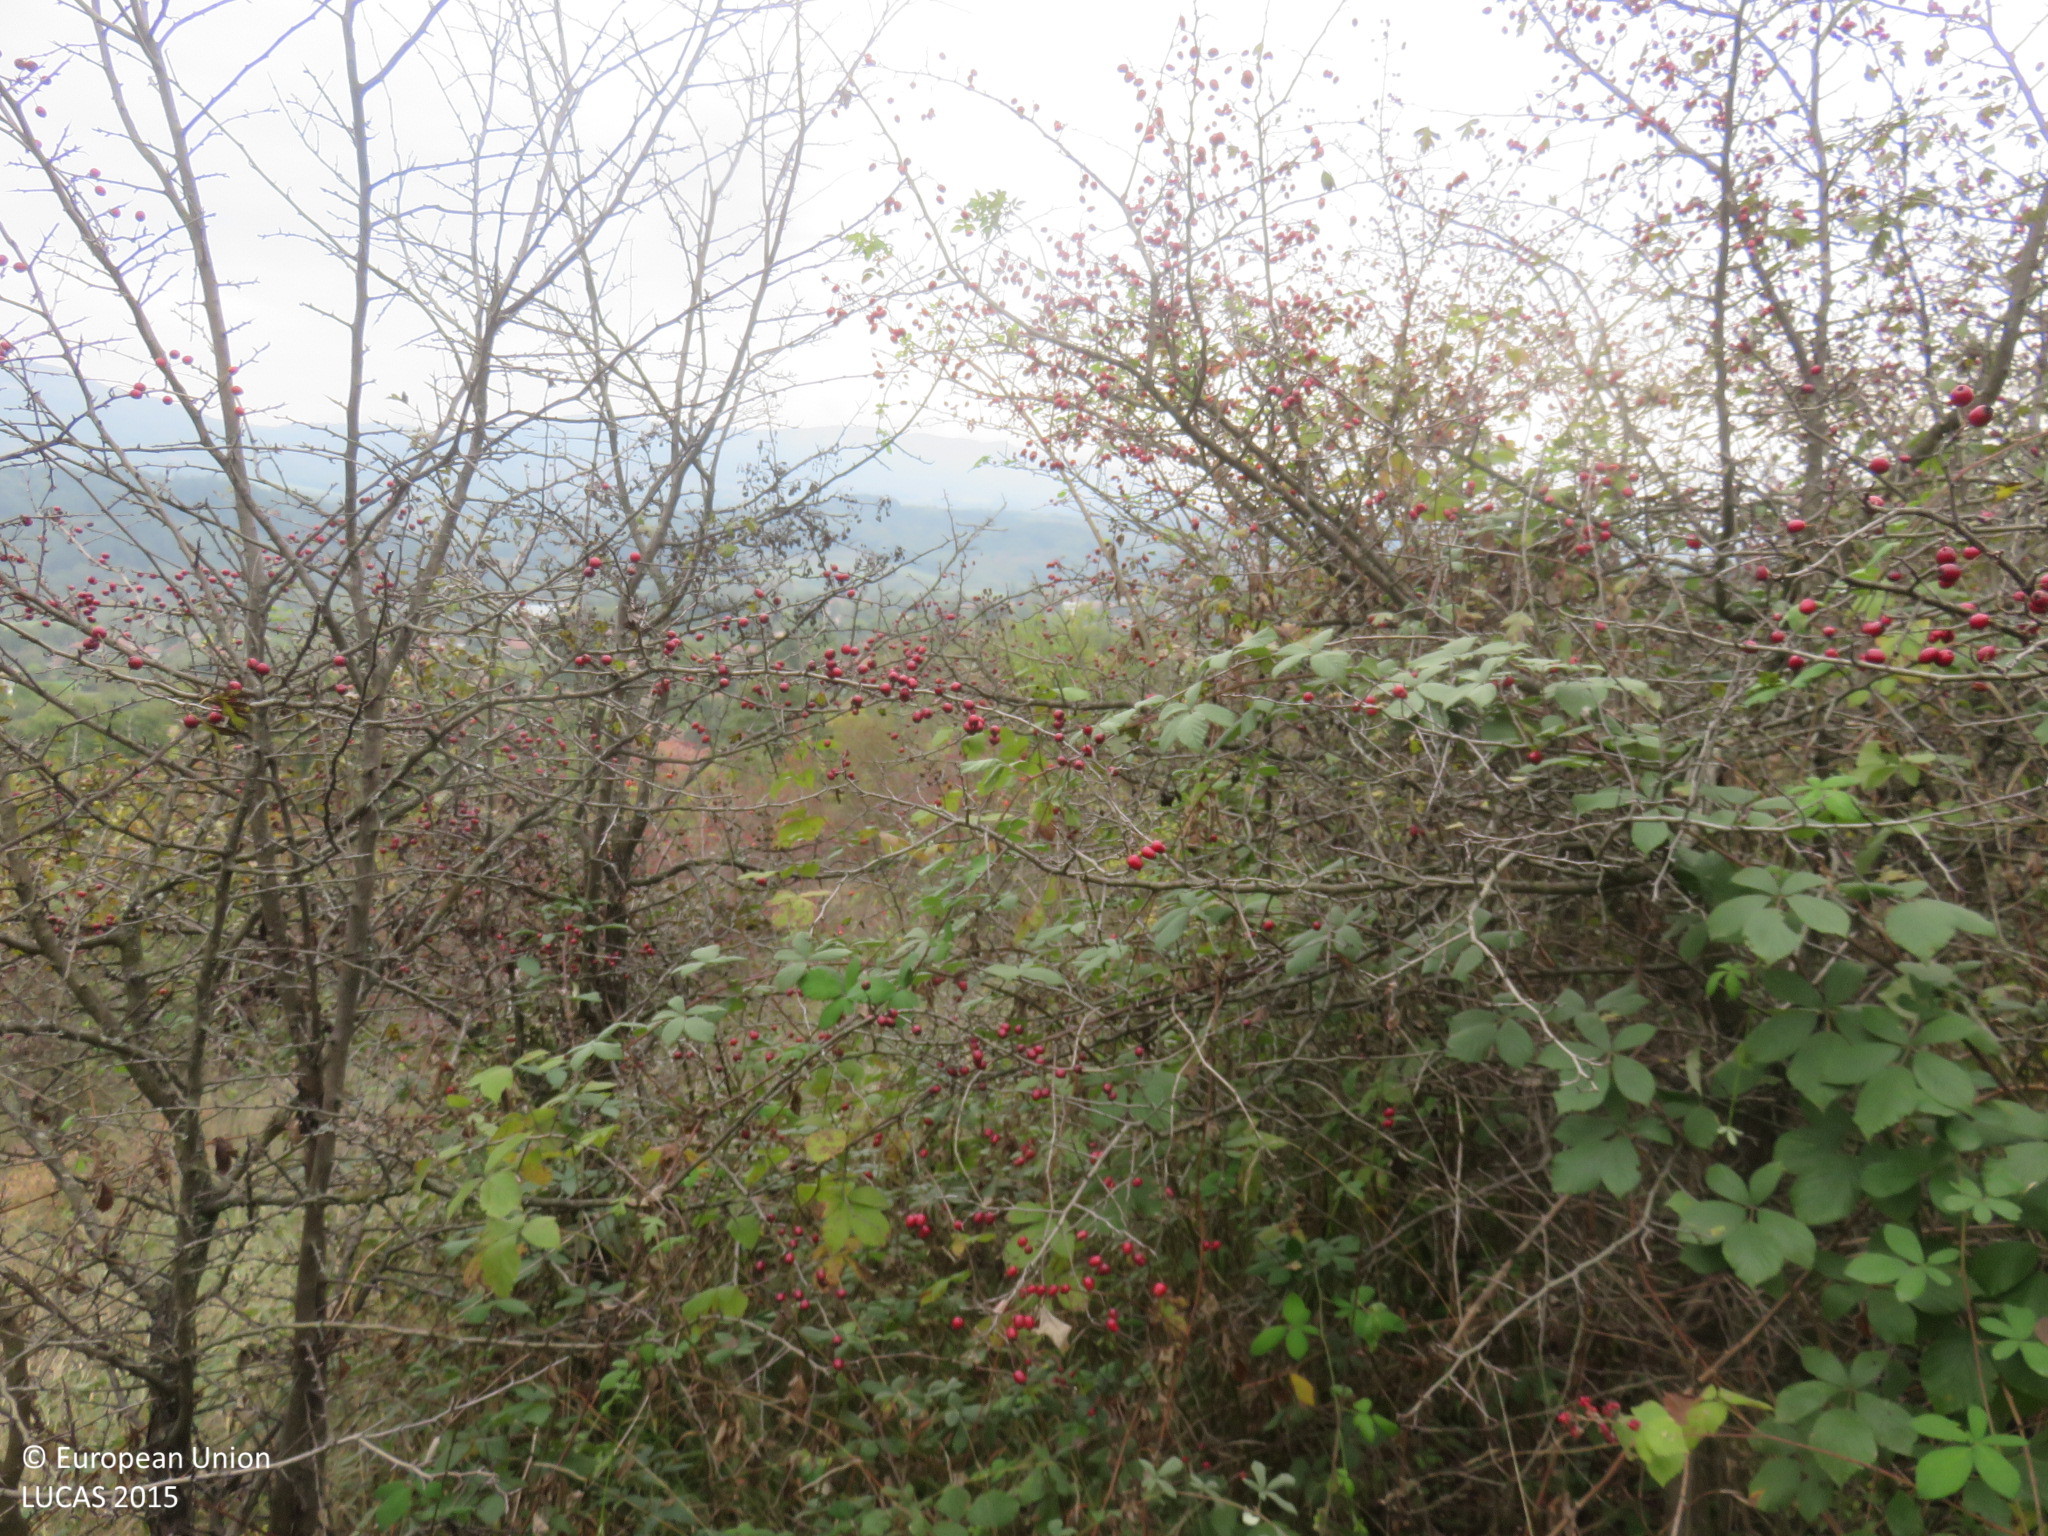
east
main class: Shrubland
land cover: Shrubland with sparse tree cover
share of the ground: > 75 %
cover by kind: shrubs 90 %, broadleaved forest trees 5 %, herbaceous plants 5 %
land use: Semi-natural and natural areas not in use
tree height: < 5 m
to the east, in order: Shrubland with sparse tree cover; Grassland with sparse tree/shrub cover; Shrubland with sparse tree cover; Electric lines; Shrubland with sparse tree cover; Grassland without tree/shrub cover; Broadleaved woodland; Shrubland with sparse tree cover; Artificial constructions in urban areas; Broadleaved woodland; Grassland without tree/shrub cover; Artificial constructions in urban areas
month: October
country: BG
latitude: 42.9331
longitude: 25.1771
